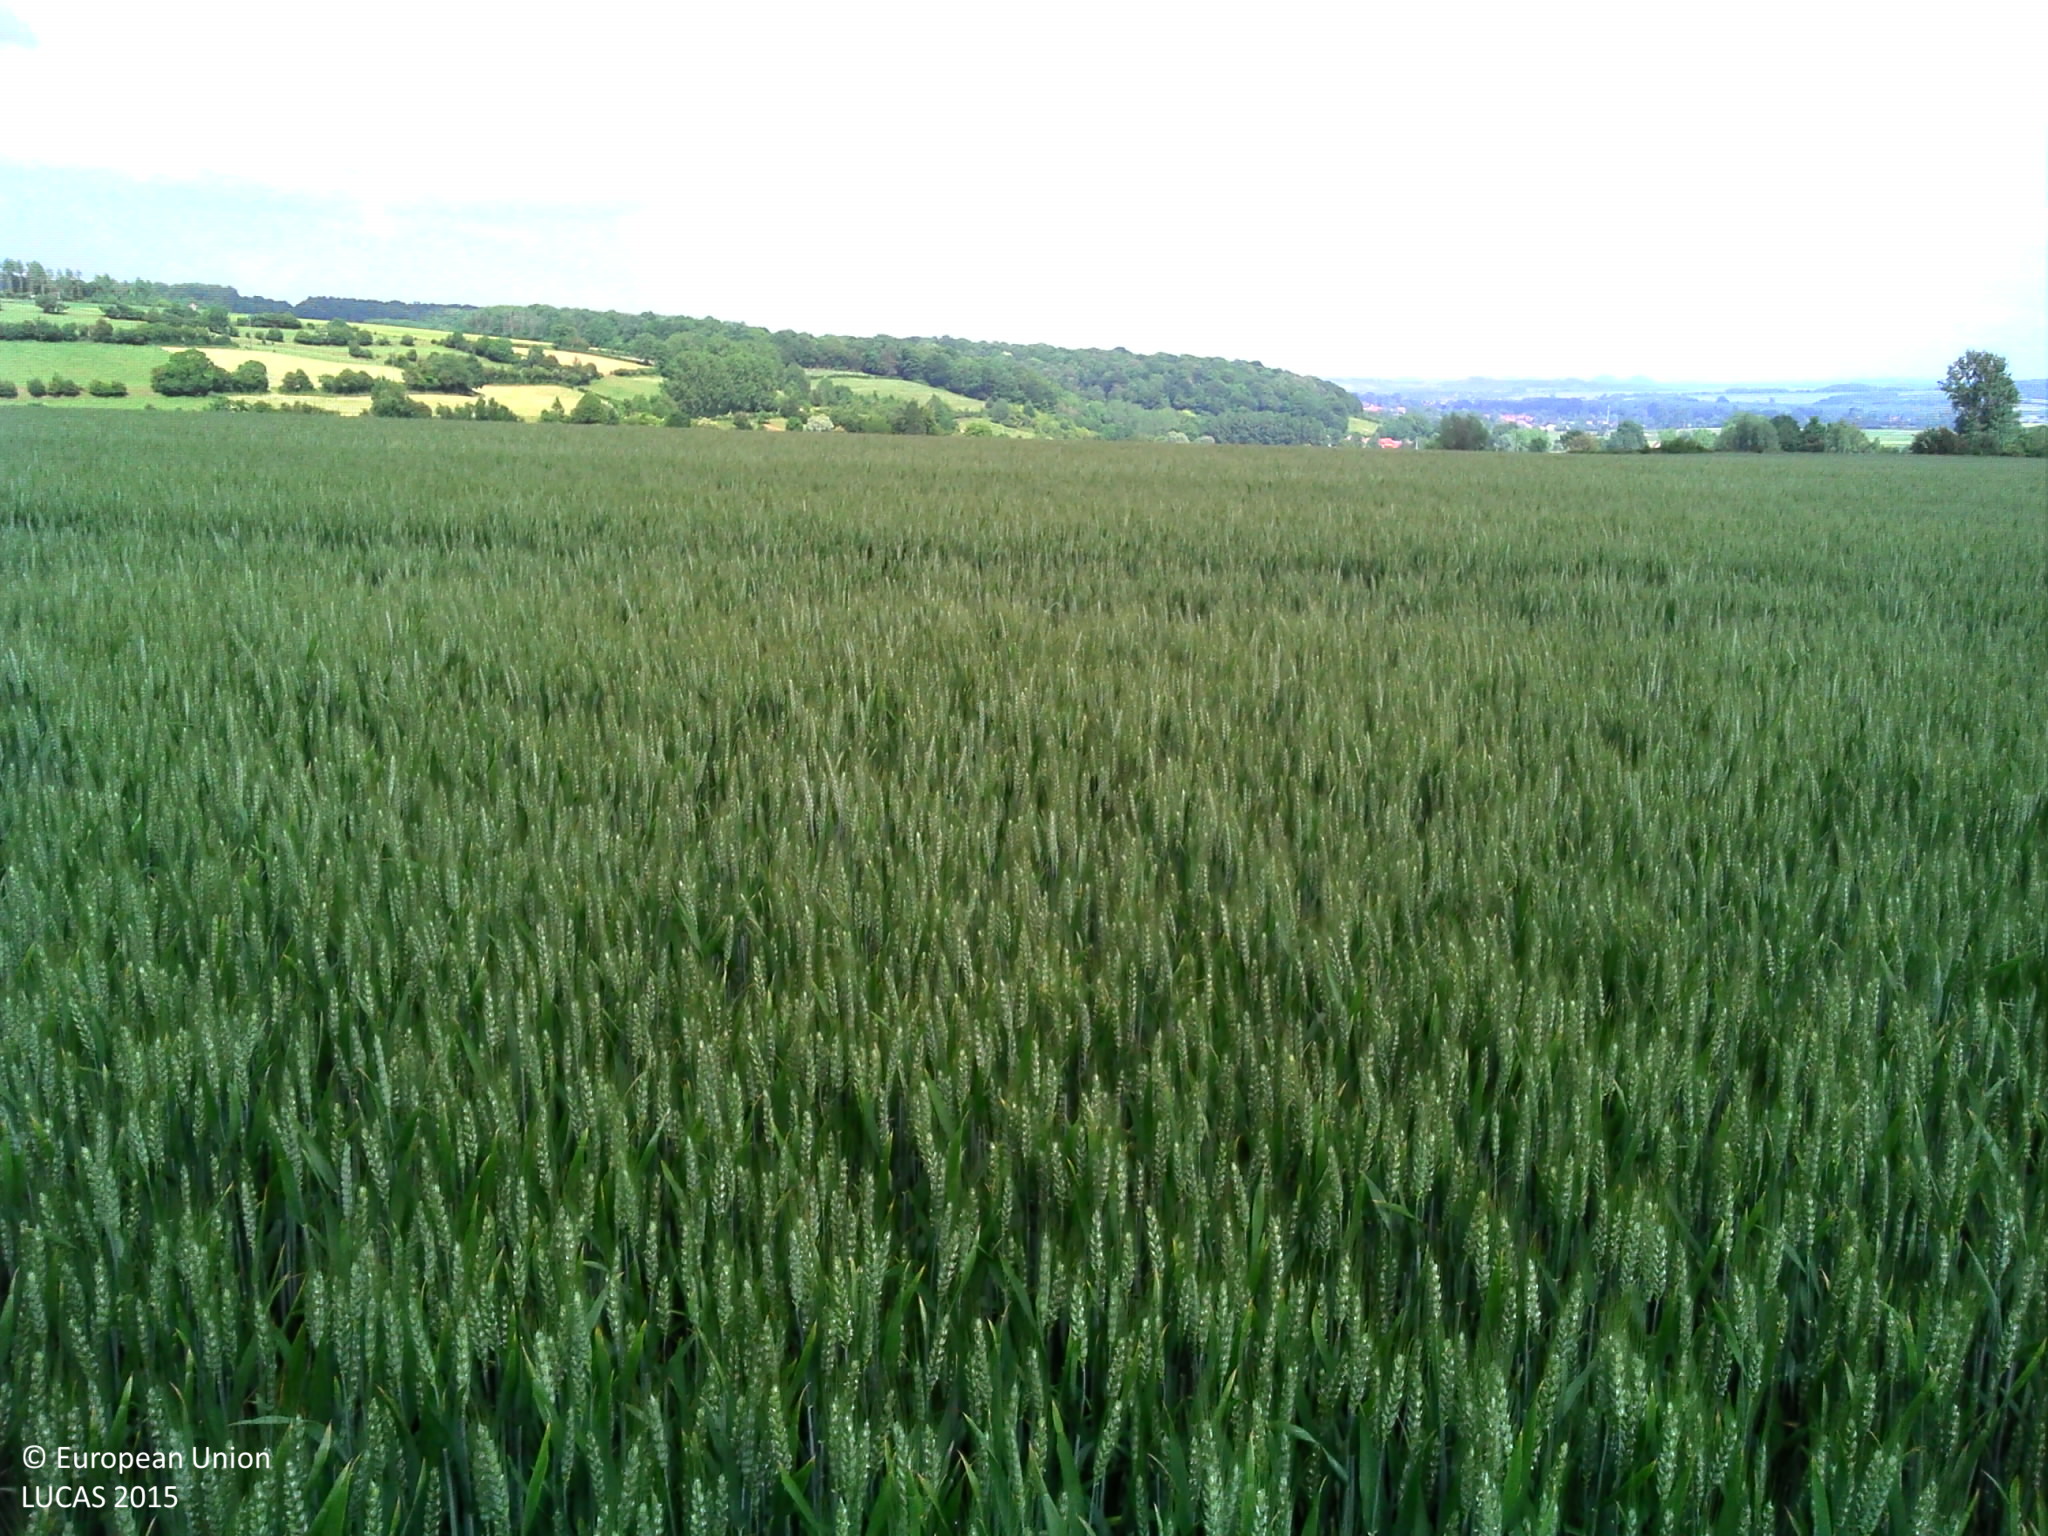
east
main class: Cropland
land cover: Common wheat
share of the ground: > 75 %
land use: Agriculture (excluding fallow land and kitchen gardens)
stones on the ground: 10 - 25 %
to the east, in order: Common wheat; Grass margins; Fences; Grassland with sparse tree/shrub cover; Fences; Grass margins; Common wheat
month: June
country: FR
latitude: 50.4877
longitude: 2.3613
